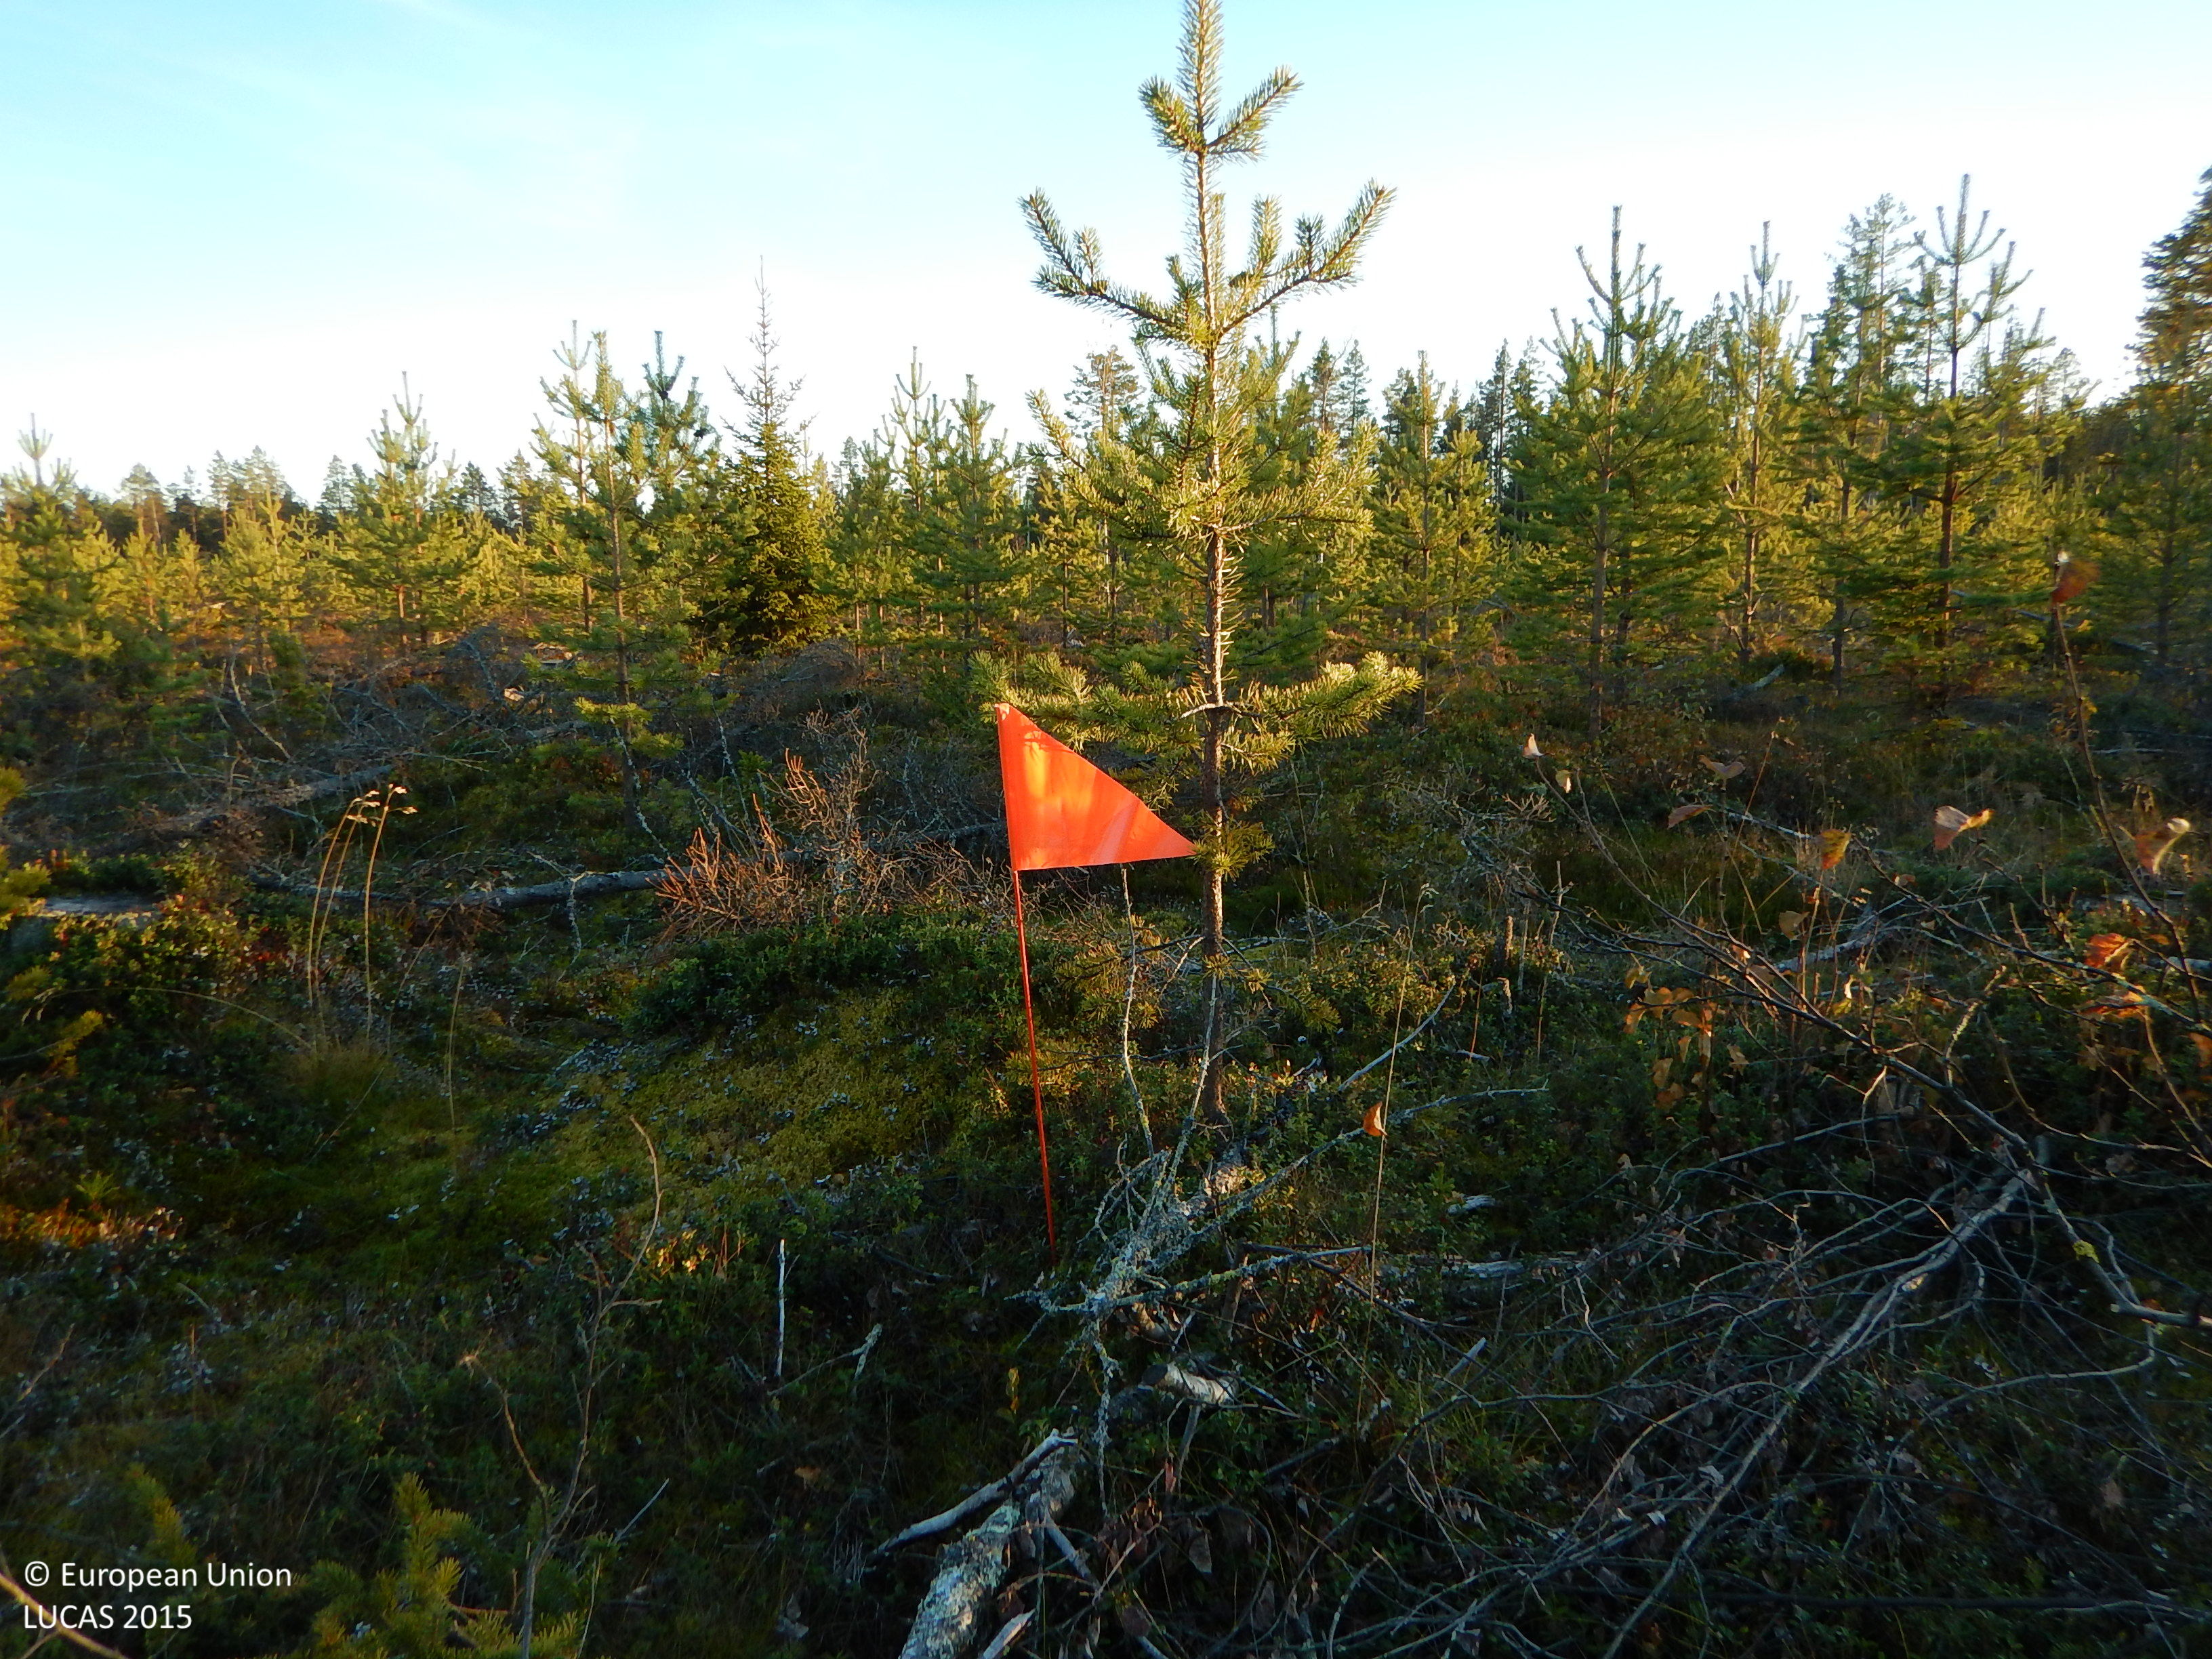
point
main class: Woodland
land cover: Pine dominated coniferous woodland
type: boreal forest
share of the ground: 50 - 75 %
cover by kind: coniferous forest trees 60 %, shrubs 15 %, lichens and mosses 15 %, broadleaved forest trees 5 %, herbaceous plants 5 %
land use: Forestry
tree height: < 5 m
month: October
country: SE
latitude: 65.1209
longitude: 20.8592
